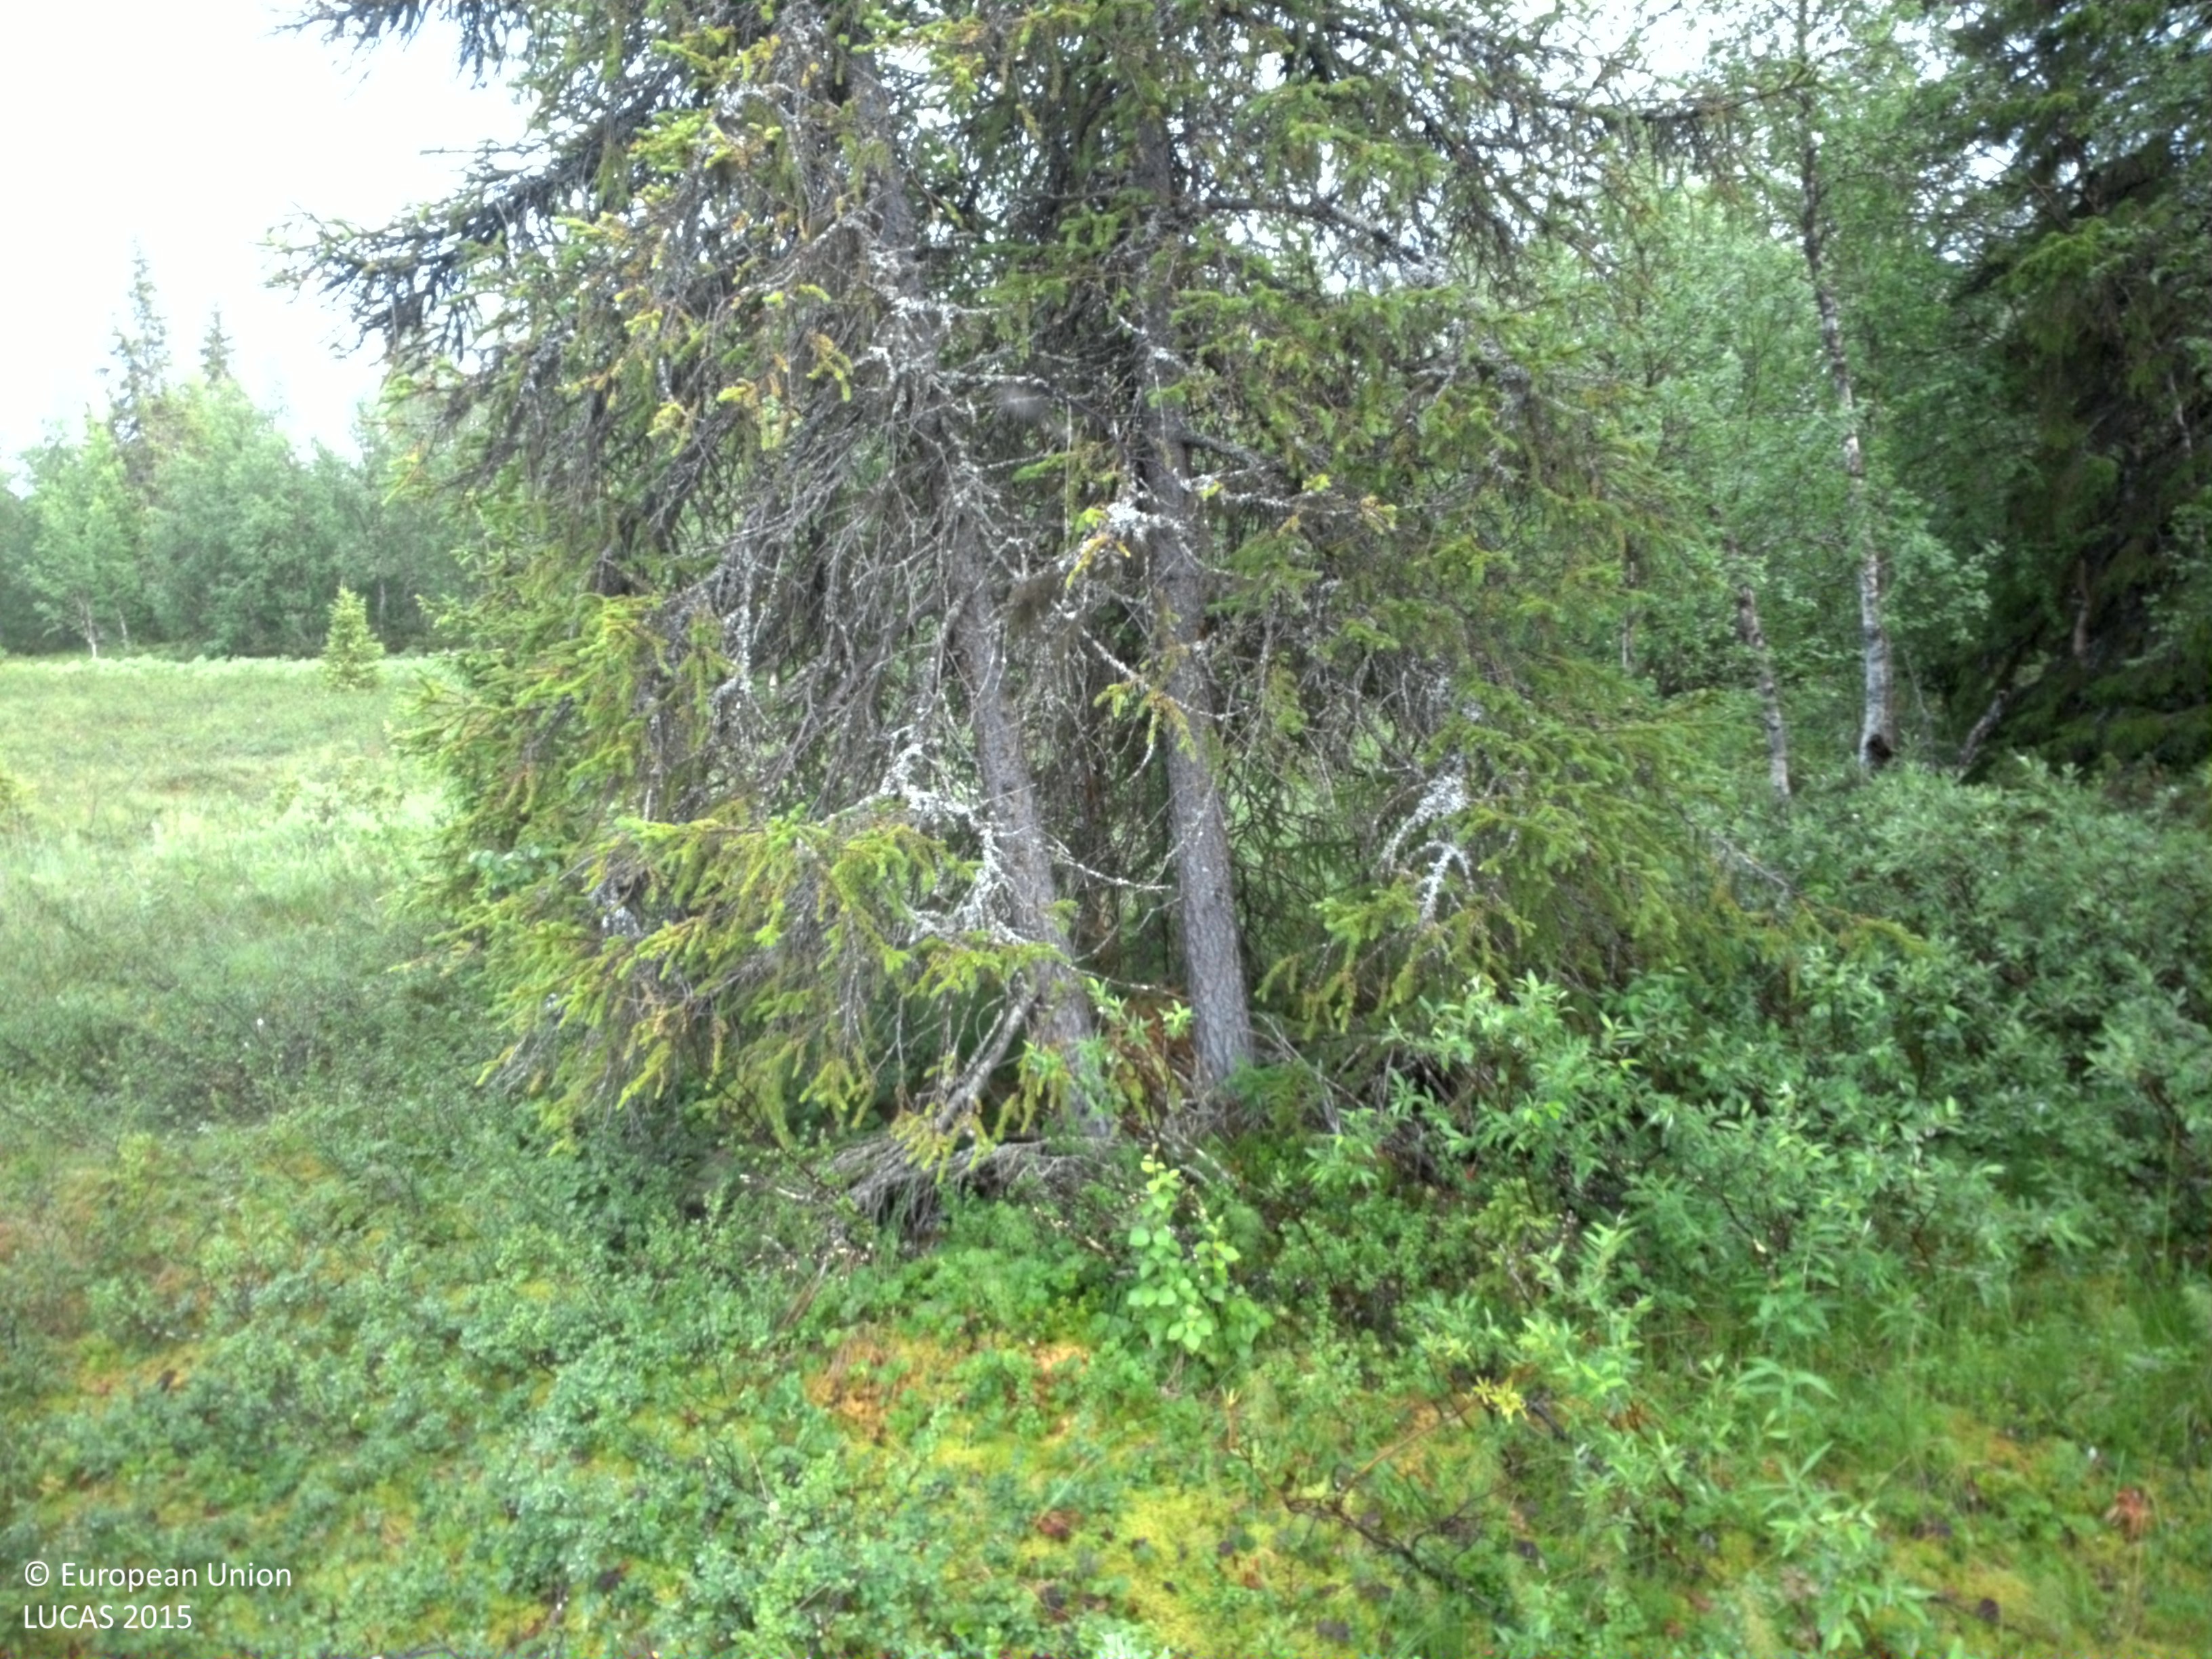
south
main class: Shrubland
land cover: Shrubland with sparse tree cover
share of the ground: 50 - 75 %
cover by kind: shrubs 50 %, lichens and mosses 35 %, herbaceous plants 10 %, coniferous forest trees 5 %
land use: Semi-natural and natural areas not in use
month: August
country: SE
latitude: 65.2550
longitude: 15.7248
